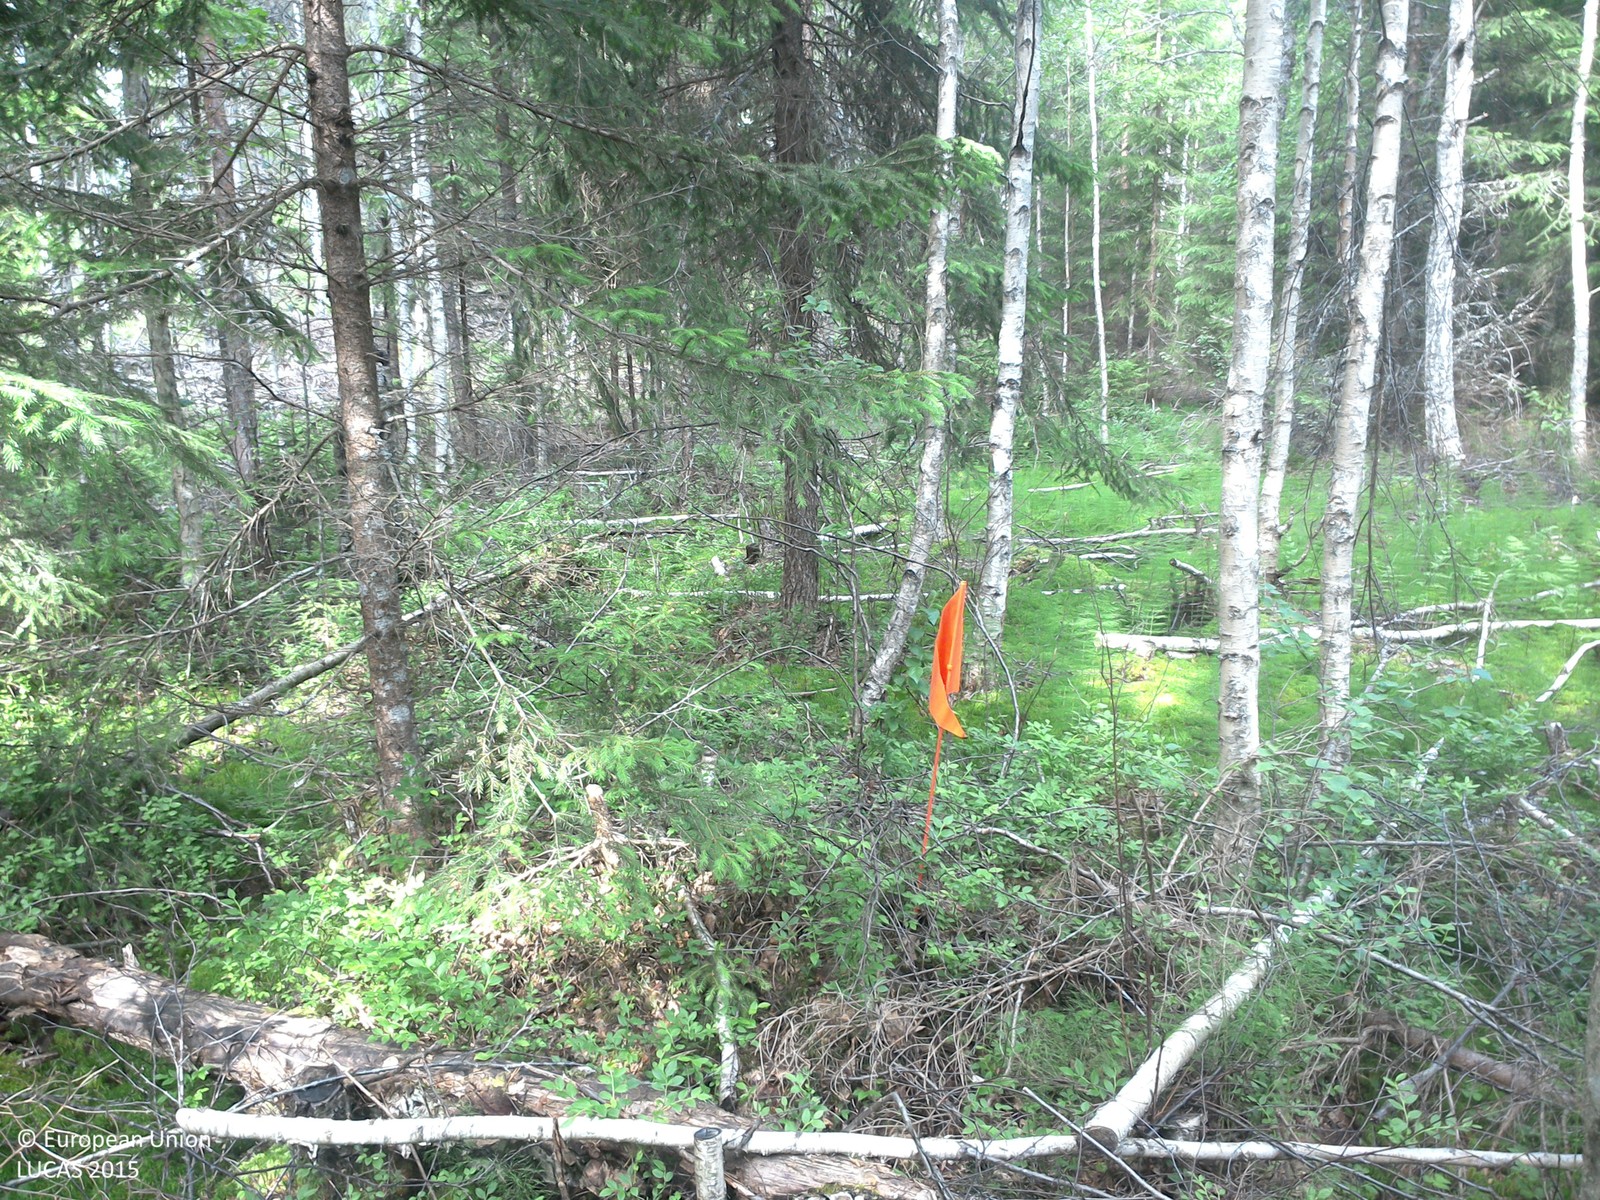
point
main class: Woodland
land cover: Spruce dominated mixed woodland
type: boreal forest
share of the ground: > 75 %
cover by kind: coniferous forest trees 60 %, broadleaved forest trees 20 %, herbaceous plants 20 %
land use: Forestry
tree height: > 5 m
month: June
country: SE
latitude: 58.0500
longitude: 15.5697
